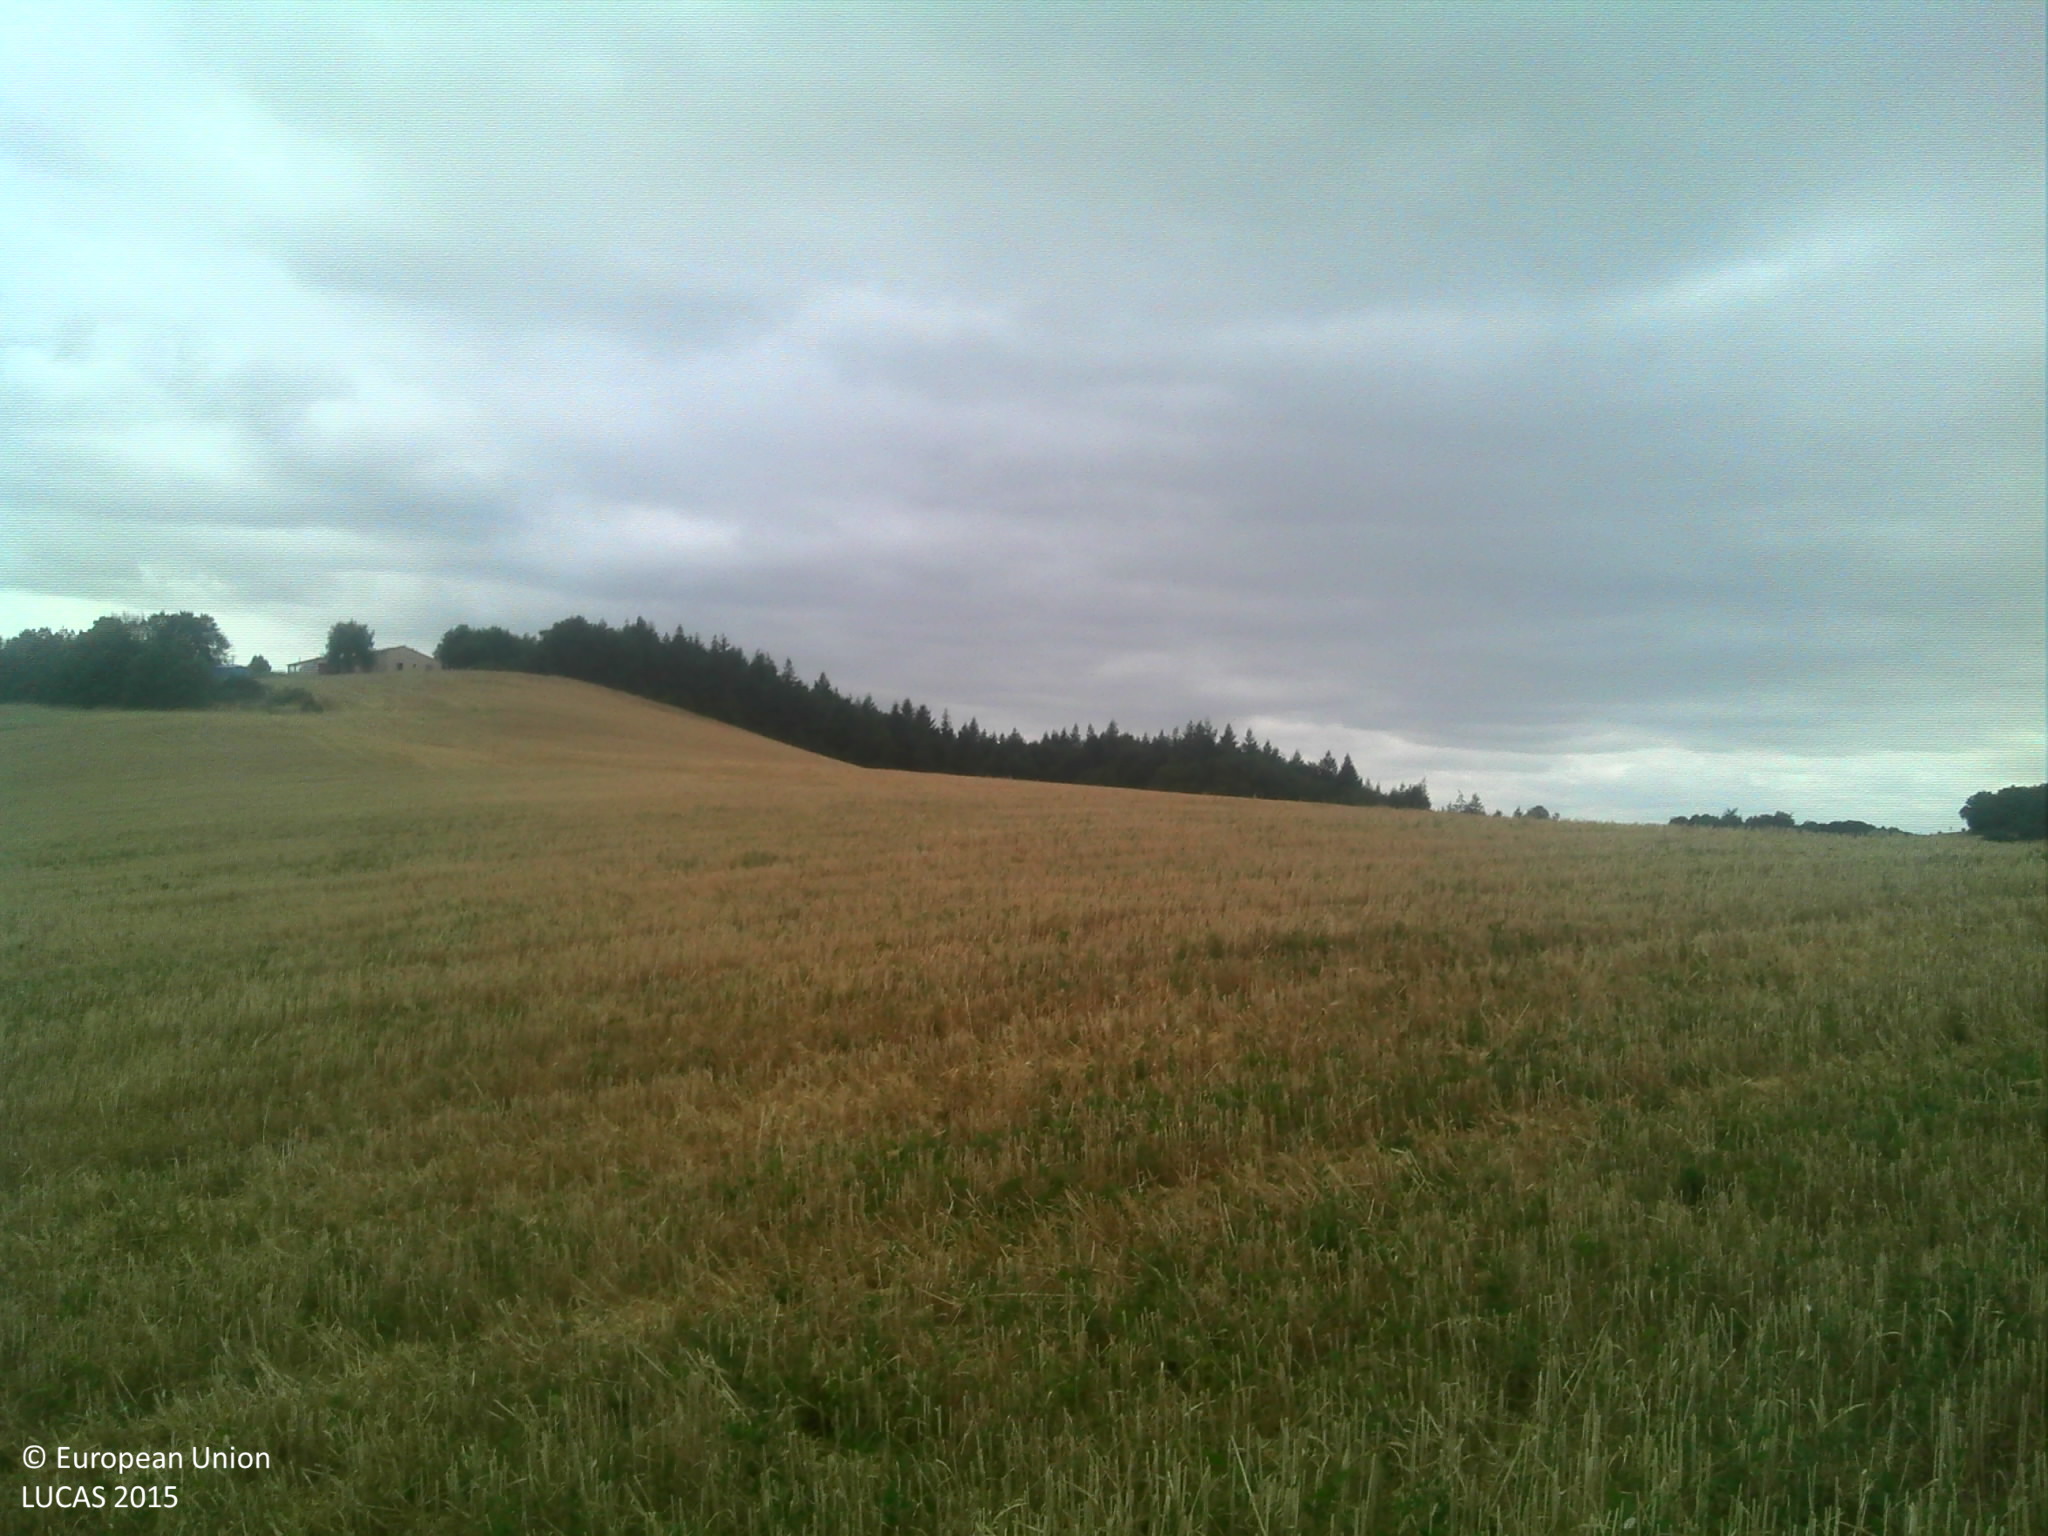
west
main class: Cropland
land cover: Common wheat
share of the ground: > 75 %
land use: Agriculture (excluding fallow land and kitchen gardens)
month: July
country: FR
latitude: 43.3049
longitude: 1.4116
